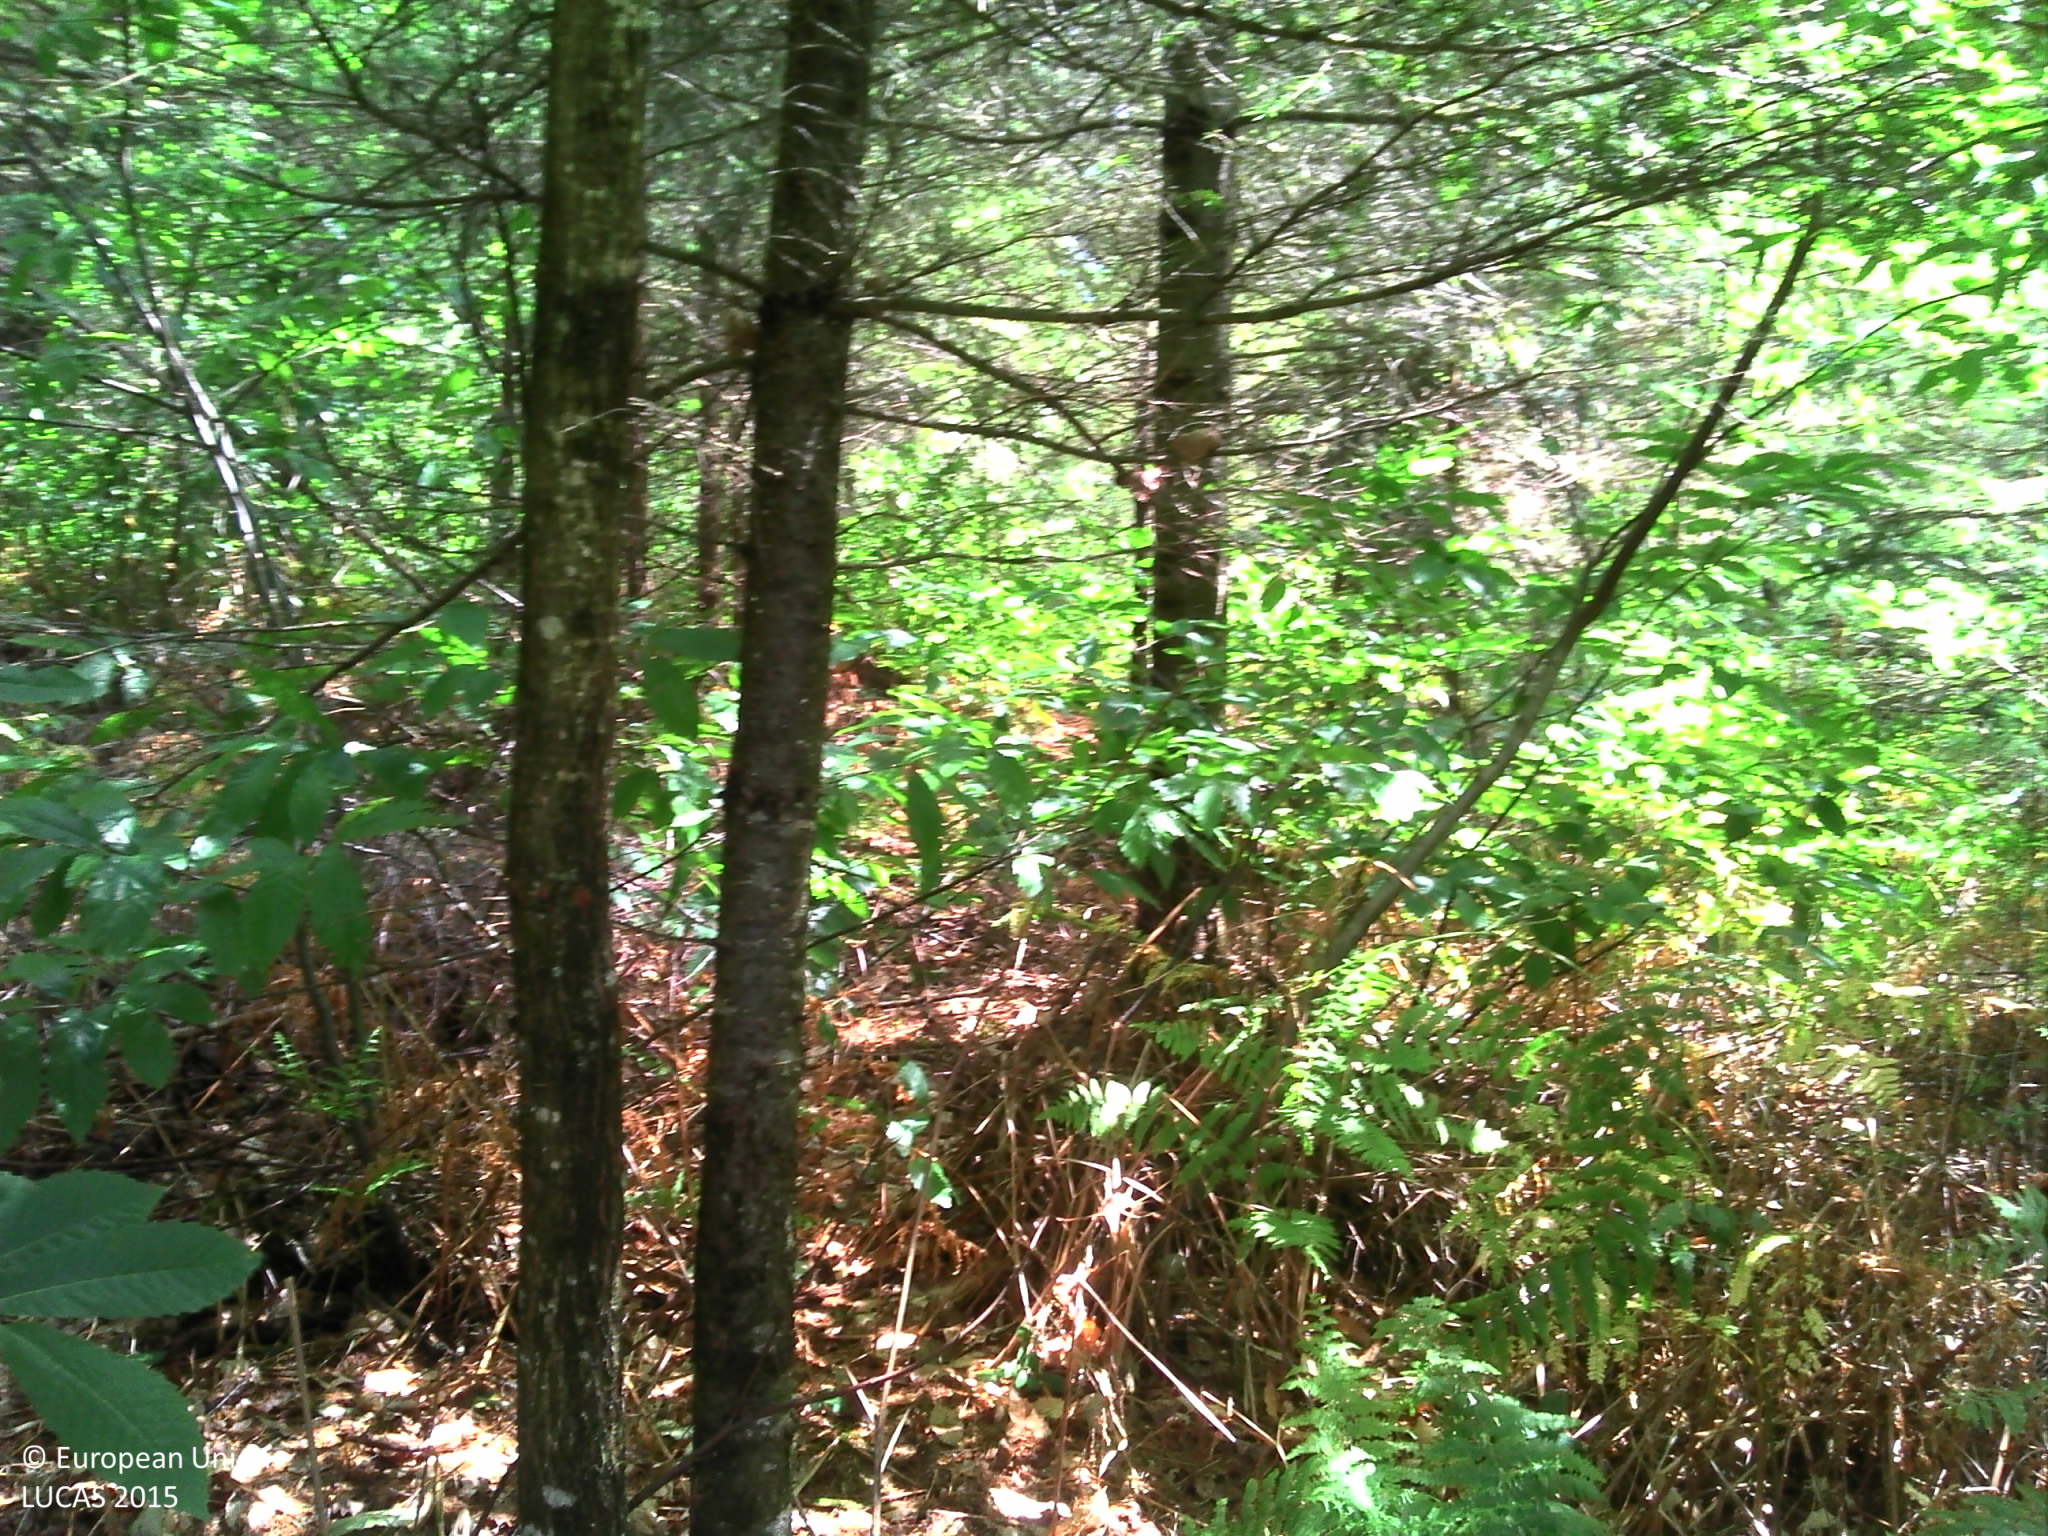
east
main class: Woodland
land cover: Other coniferous woodland
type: exotic forest
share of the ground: > 75 %
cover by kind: coniferous forest trees 80 %, shrubs 20 %
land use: Forestry
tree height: > 5 m
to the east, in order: Other coniferous woodland; Other bare soil; Ditches and canals; Grass margins; Paved roads, cycling and walking lanes; Grass margins; Ditches and canals; Shrubland without tree cover; Other coniferous woodland; Grass margins; Paved roads, cycling and walking lanes; Grass margins; Fences; Other coniferous woodland; Broadleaved woodland; Pine dominated mixed woodland
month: July
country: FR
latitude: 44.7423
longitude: 2.4109
